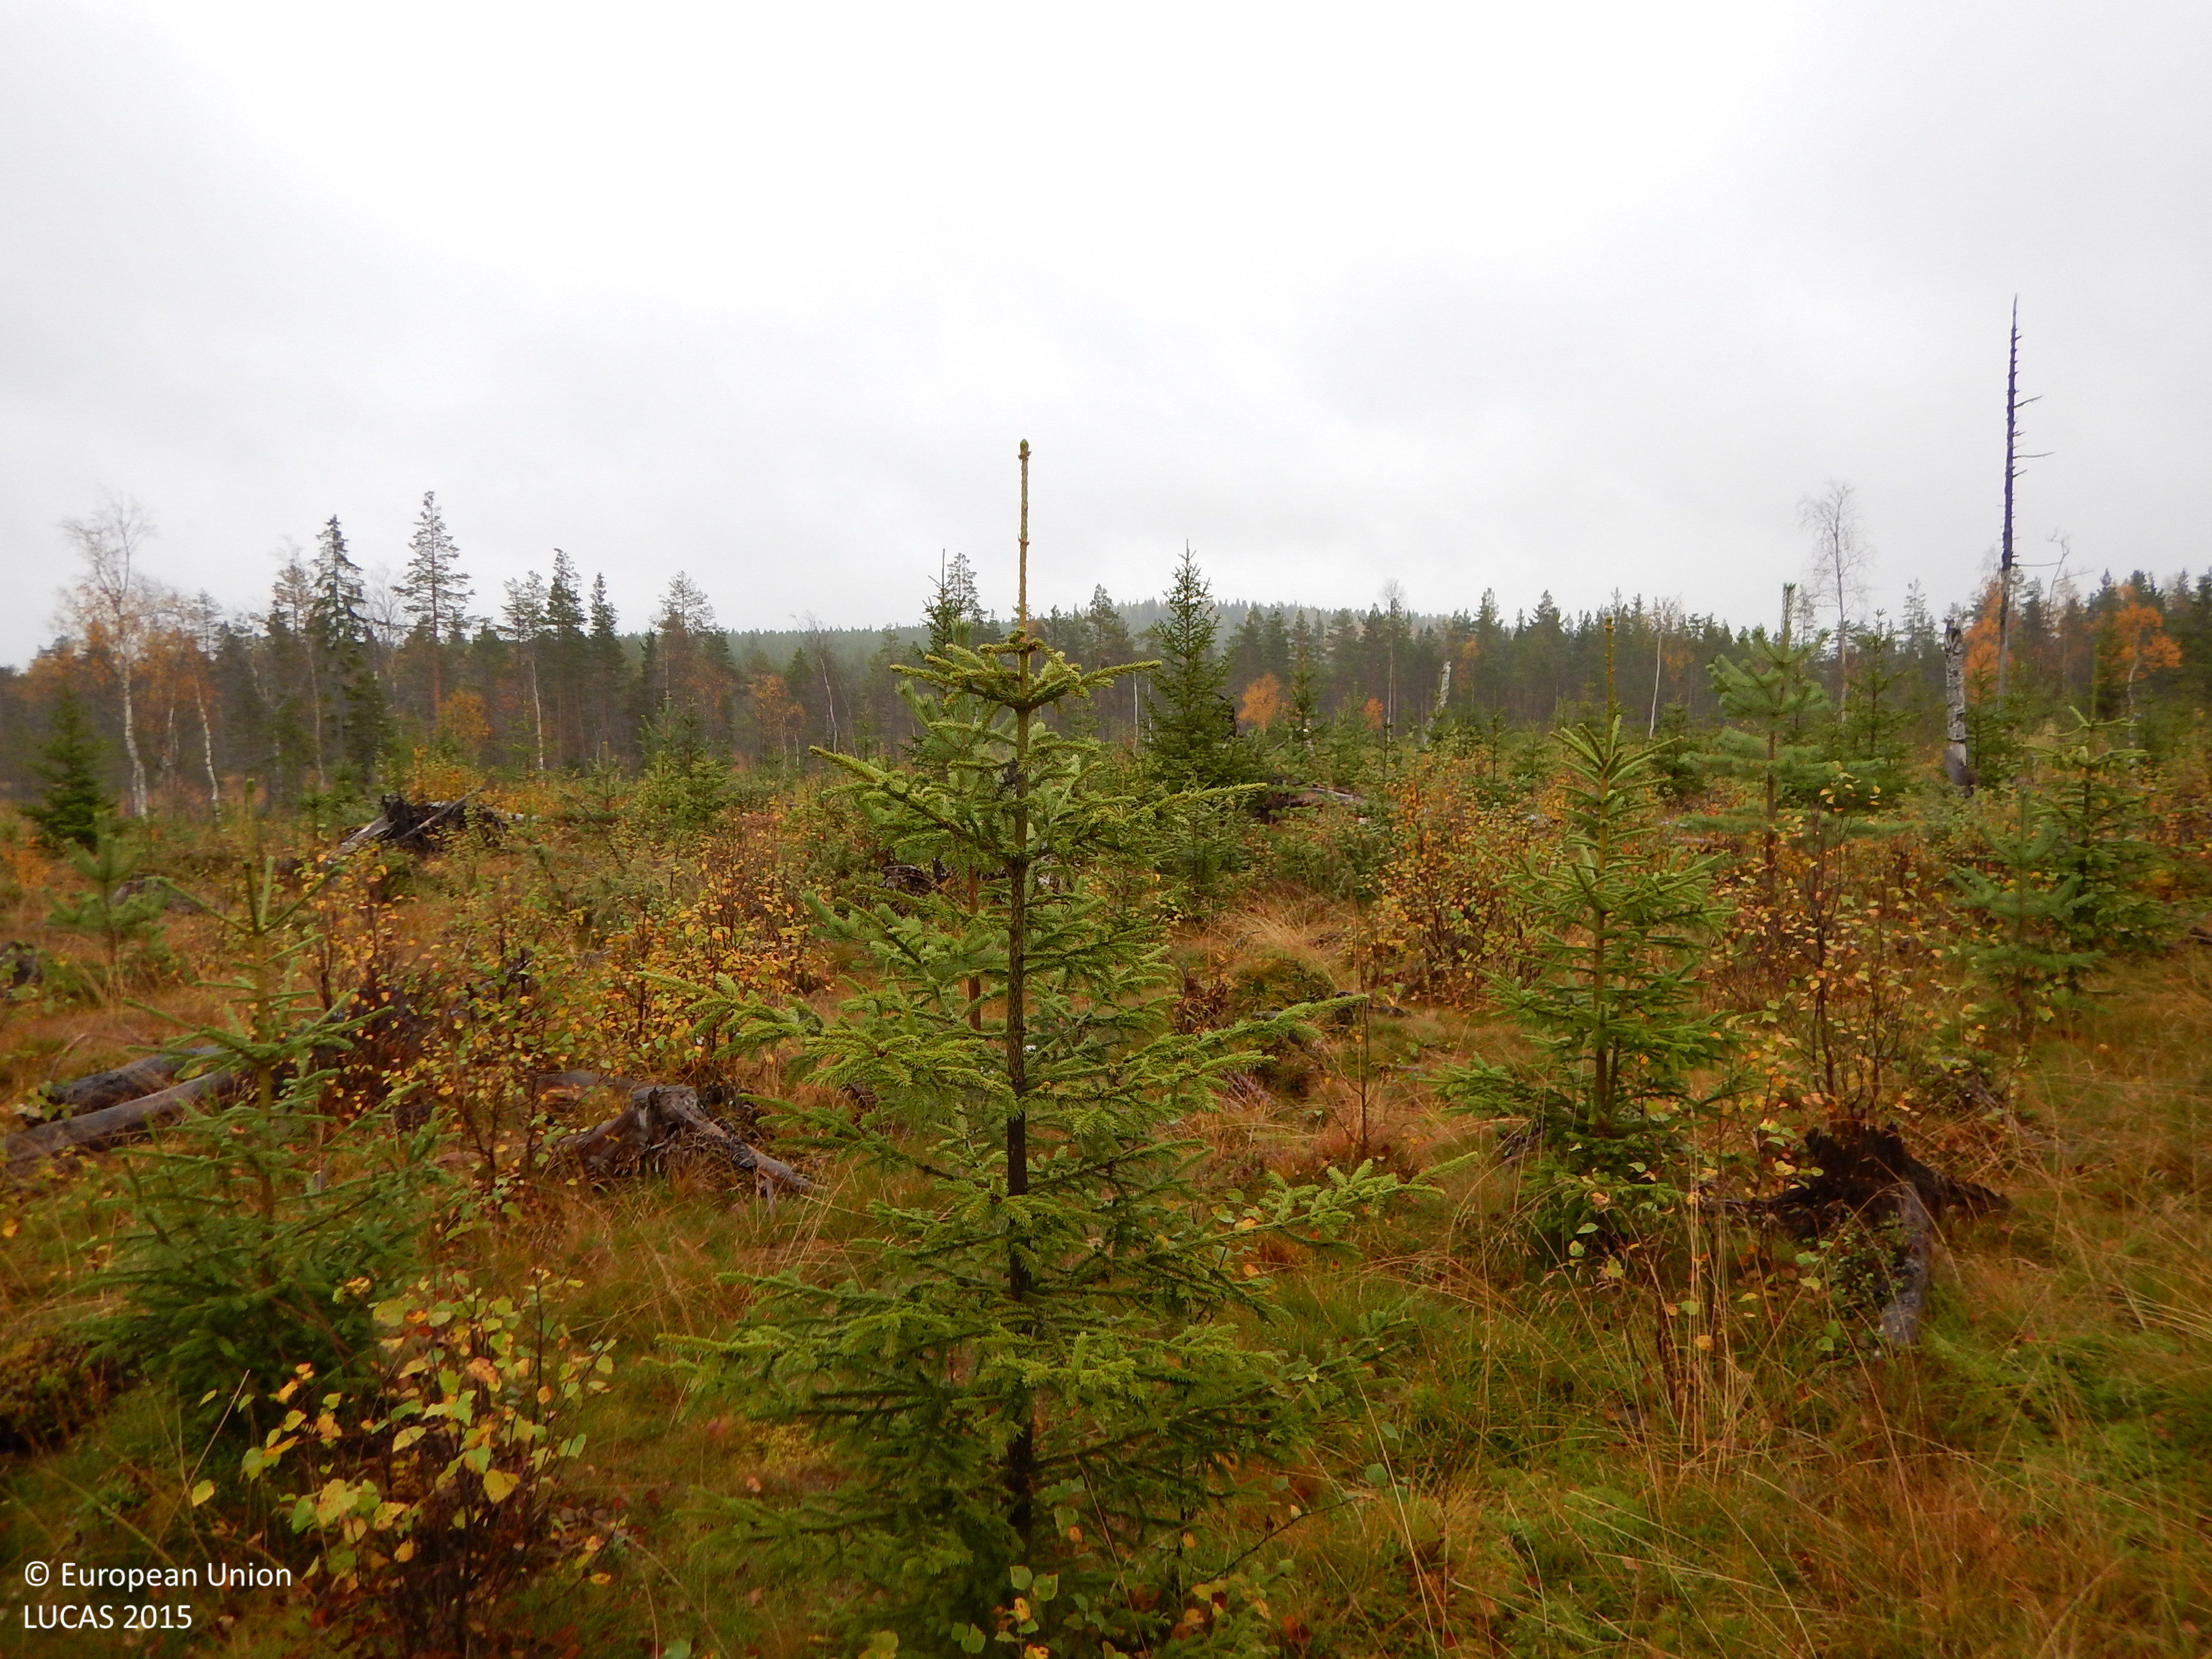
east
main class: Woodland
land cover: Other mixed woodland
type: boreal forest
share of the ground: 50 - 75 %
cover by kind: coniferous forest trees 35 %, broadleaved forest trees 20 %, lichens and mosses 20 %, herbaceous plants 15 %, shrubs 10 %
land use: Forestry
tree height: < 5 m
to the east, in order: Other mixed woodland; Pine dominated mixed woodland; Pine dominated coniferous woodland; Rivers and streams; Pine dominated mixed woodland; Rivers and streams; Other mixed woodland
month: September
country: SE
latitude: 65.0385
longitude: 19.2465
